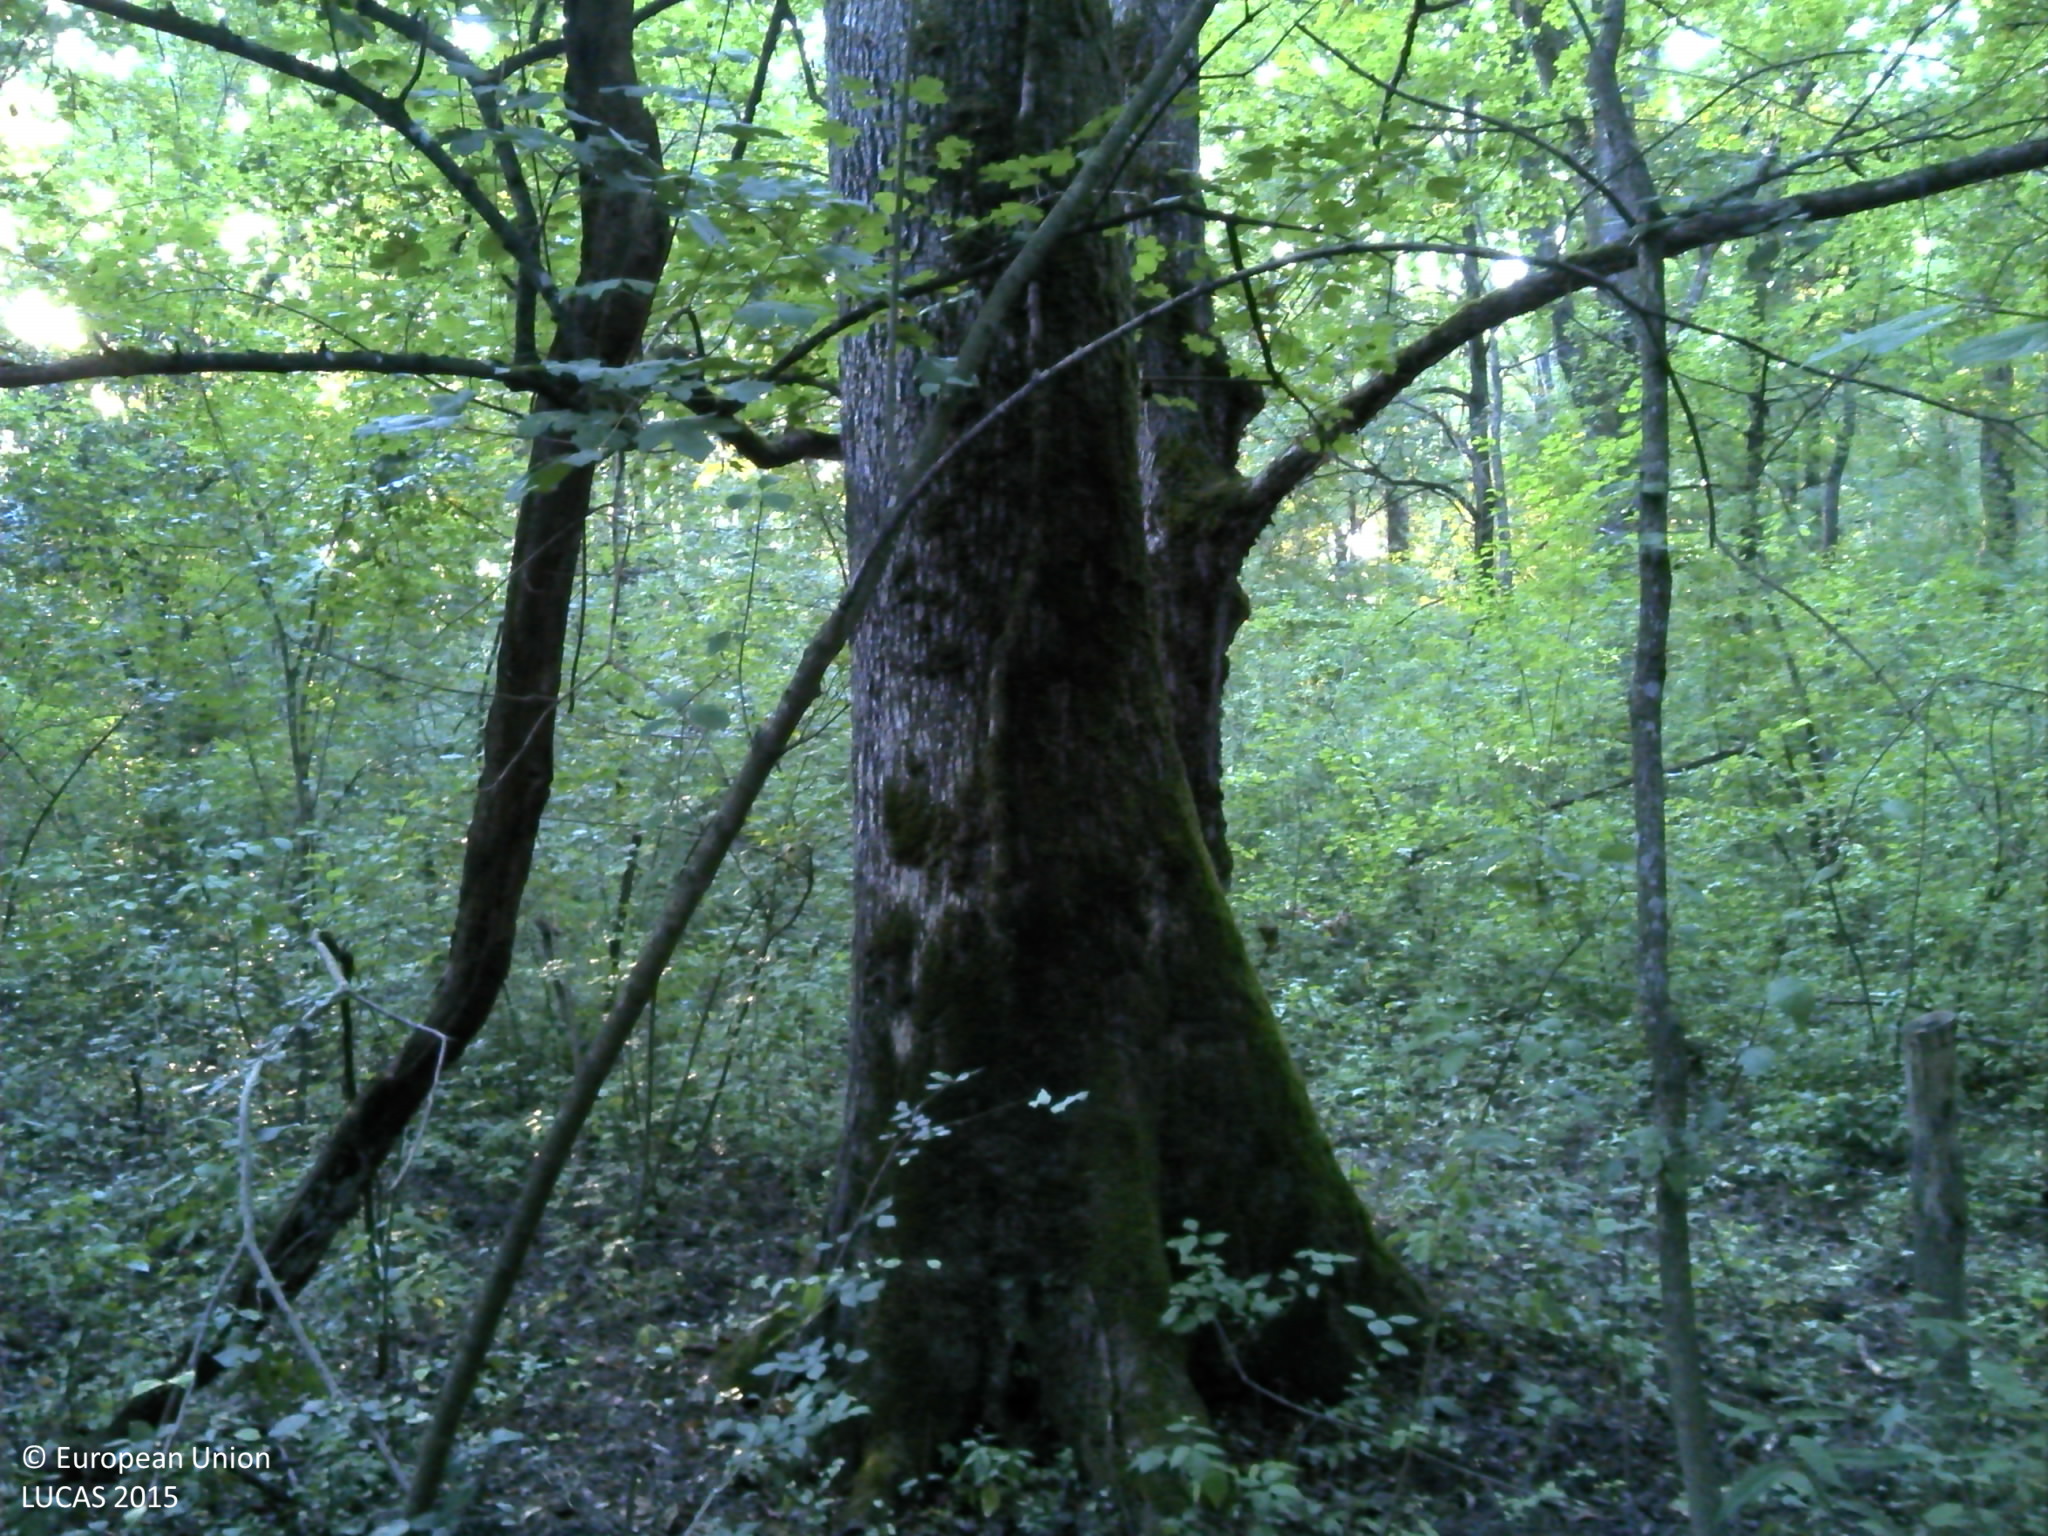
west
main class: Woodland
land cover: Broadleaved woodland
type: acidophilous oak and oak-birch forest
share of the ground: > 75 %
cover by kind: broadleaved forest trees 100 %
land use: Forestry
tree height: > 5 m
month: August
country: HR
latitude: 45.5247
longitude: 16.4381
